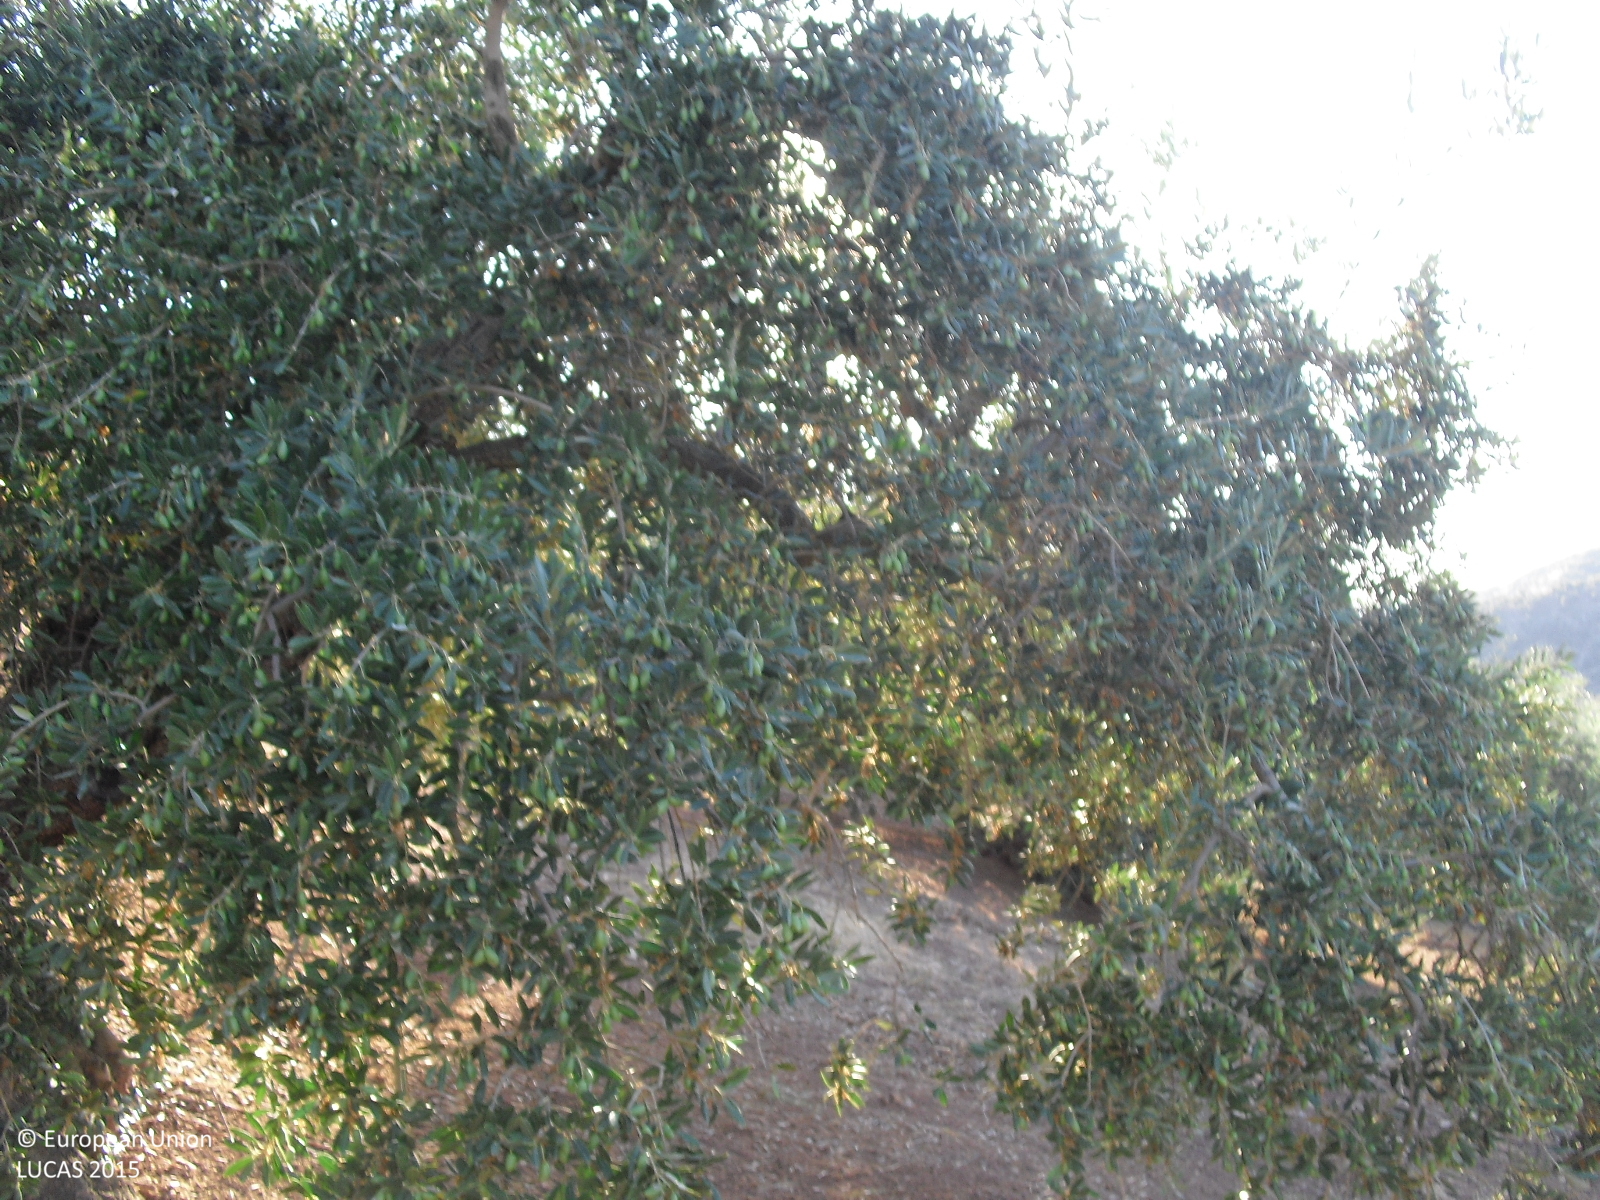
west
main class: Cropland
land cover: Olive groves
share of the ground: 25 - 50 %
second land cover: Other bare soil
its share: > 75 %
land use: Agriculture (excluding fallow land and kitchen gardens)
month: August
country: ES
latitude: 37.2752
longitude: -4.1273
